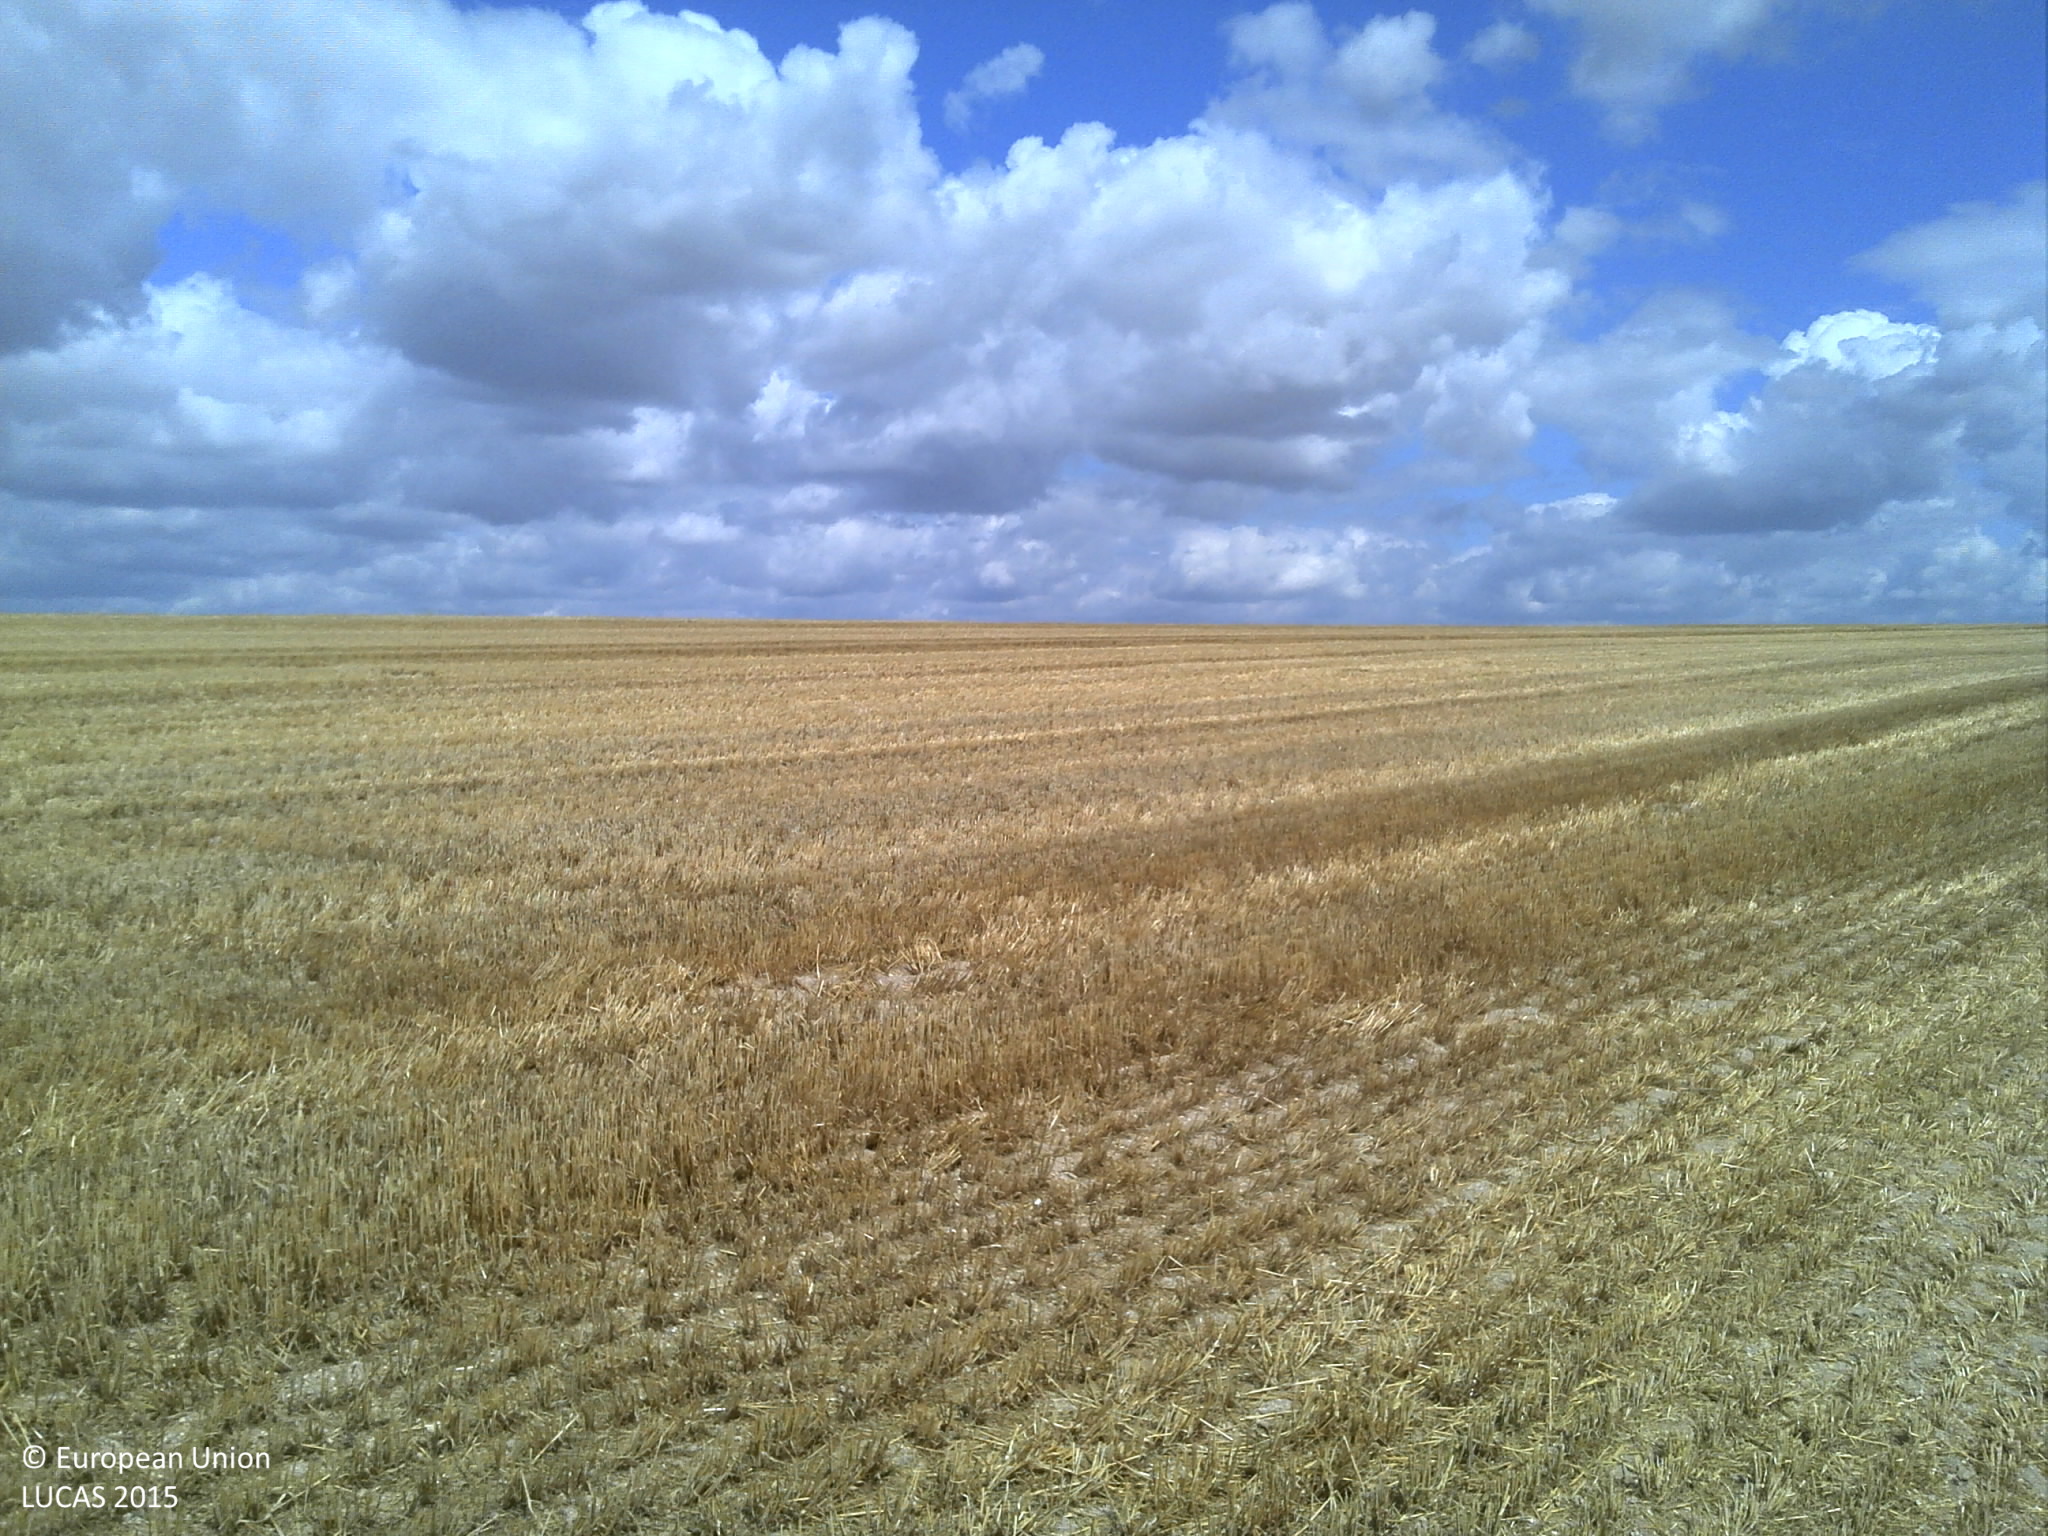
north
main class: Cropland
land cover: Barley
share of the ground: 50 - 75 %
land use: Agriculture (excluding fallow land and kitchen gardens)
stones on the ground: < 10 %
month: July
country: FR
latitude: 49.3002
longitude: 4.6197
